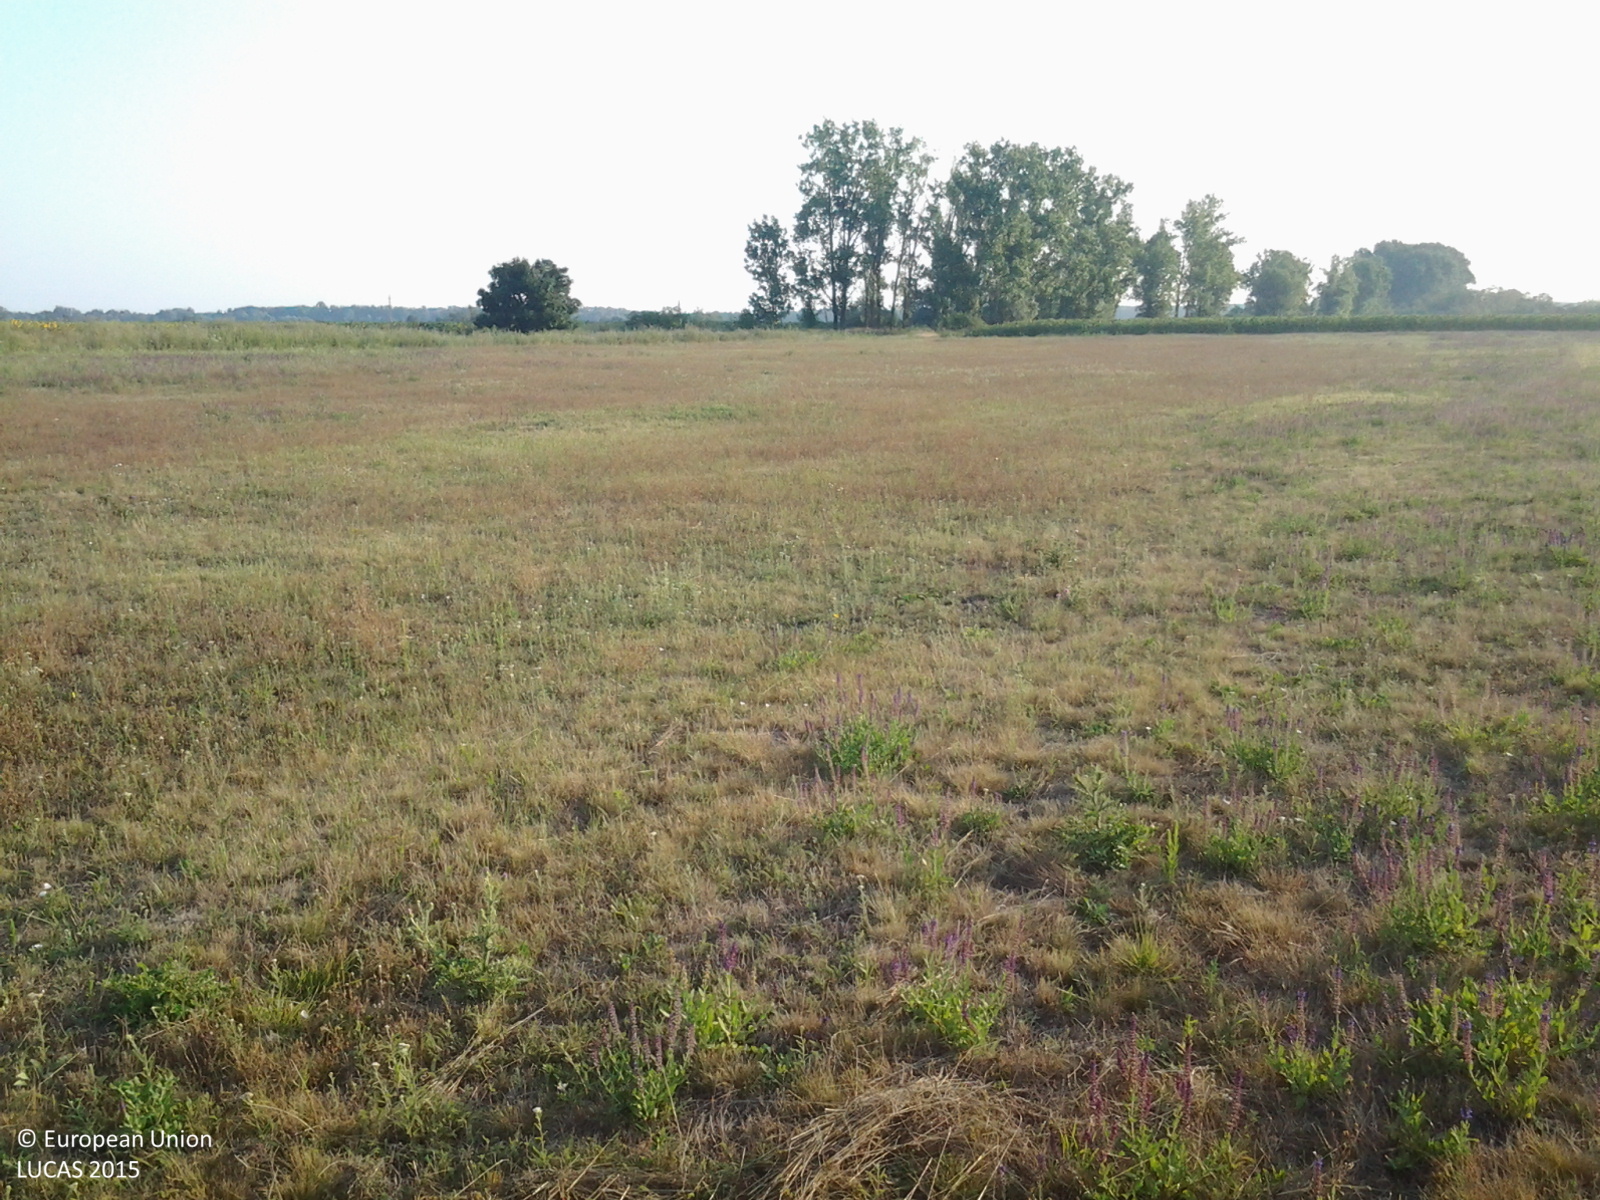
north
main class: Grassland
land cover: Grassland without tree/shrub cover
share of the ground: > 75 %
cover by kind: herbaceous plants 100 %
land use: Agriculture (excluding fallow land and kitchen gardens)
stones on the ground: < 10 %
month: July
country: HU
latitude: 46.9017
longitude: 20.8887
